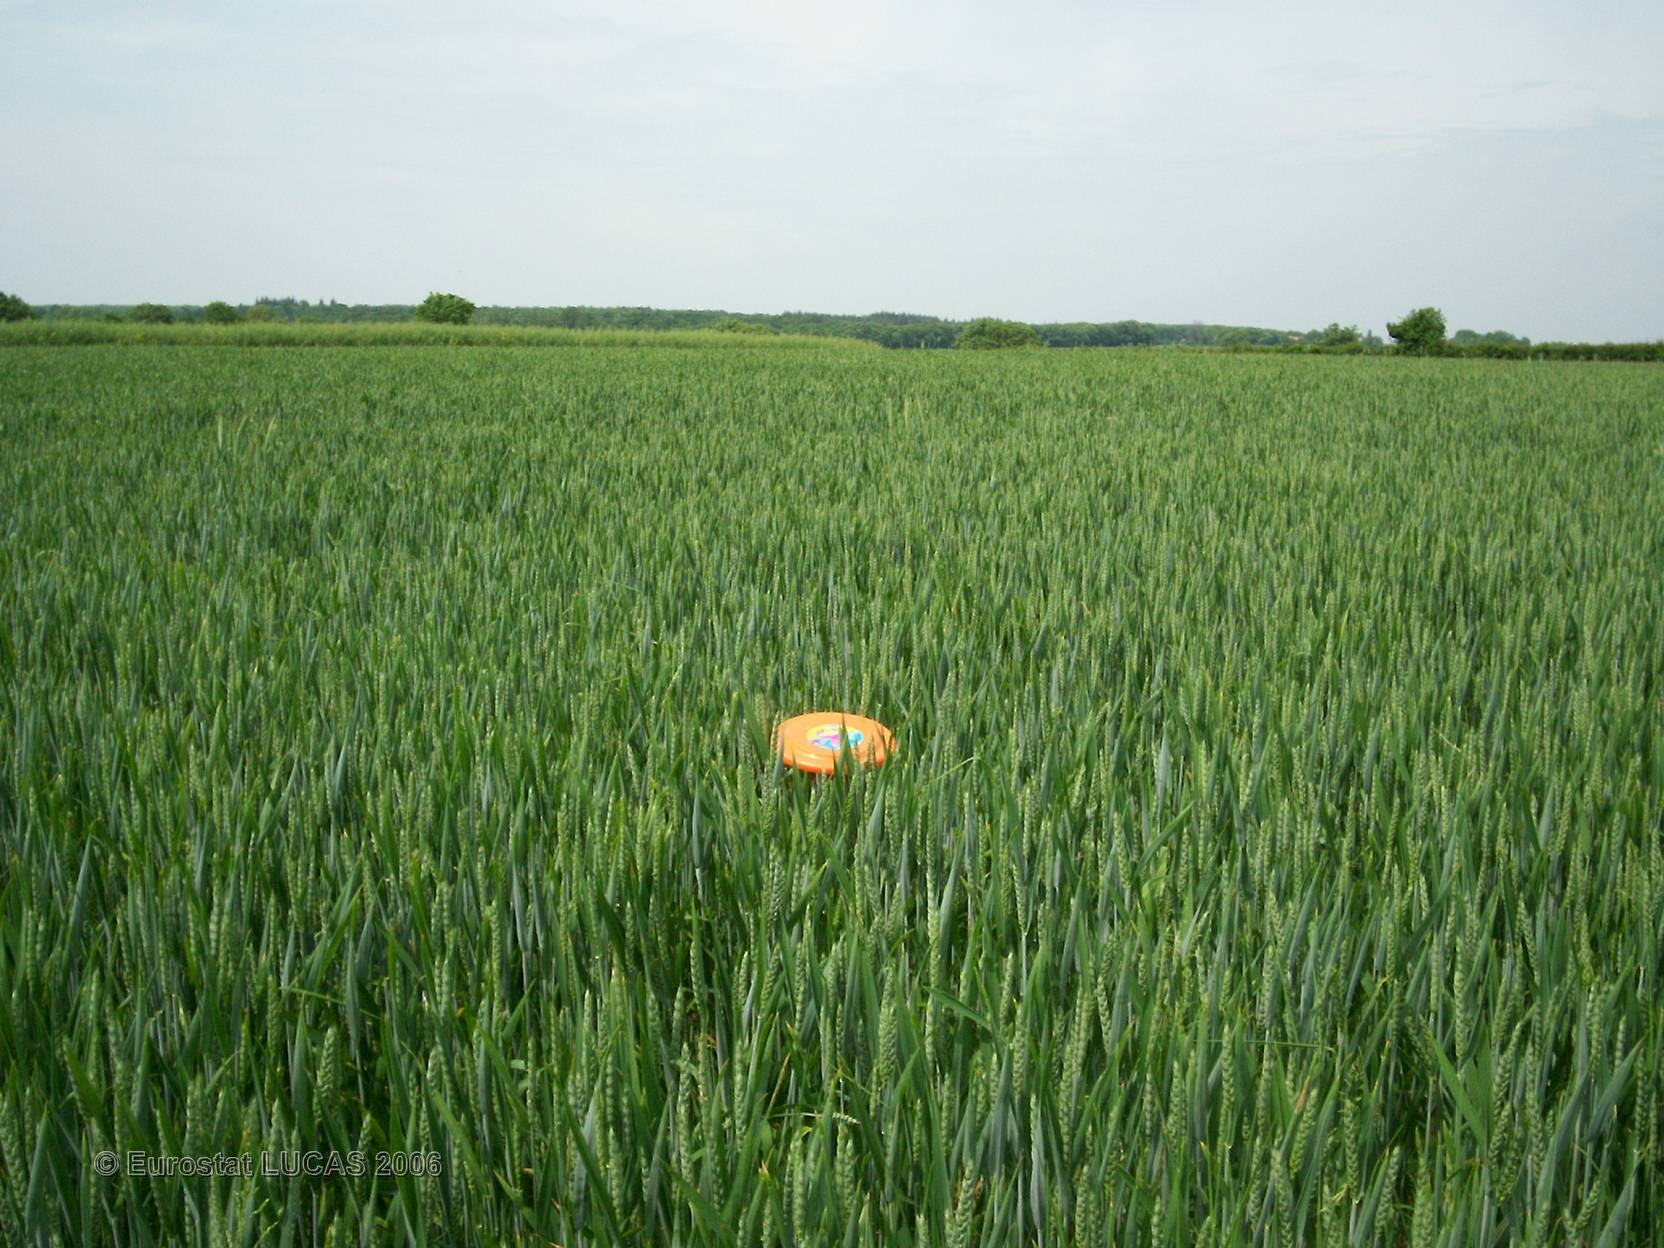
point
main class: Cropland
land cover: Common wheat
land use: Agriculture (excluding fallow land and kitchen gardens)
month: May
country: FR
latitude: 46.4698
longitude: -0.2996
